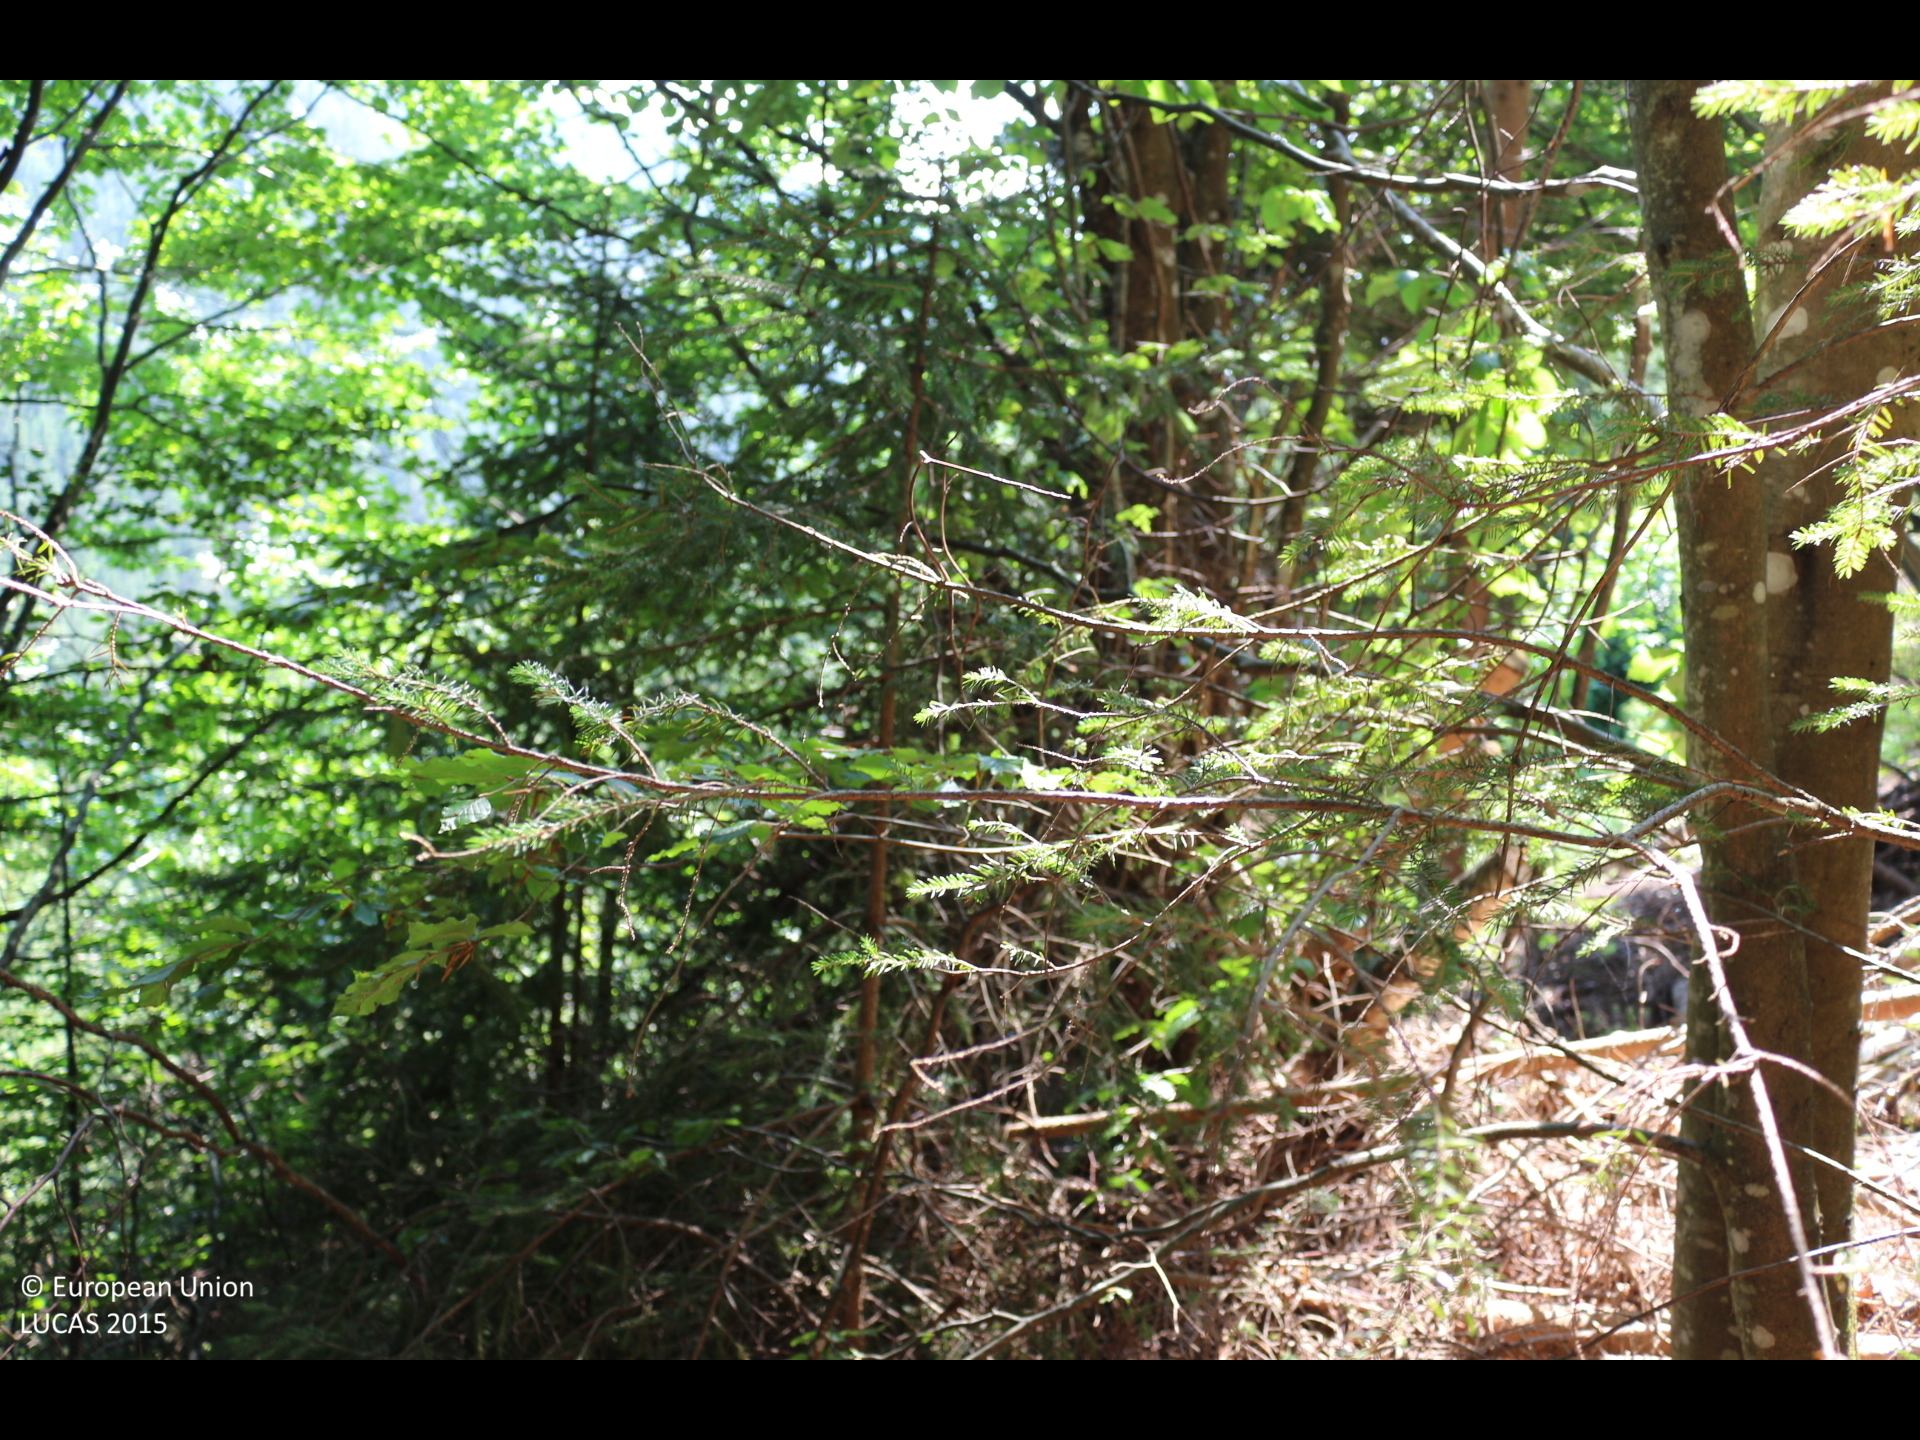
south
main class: Woodland
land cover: Spruce dominated mixed woodland
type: alpine coniferous forest
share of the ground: > 75 %
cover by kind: broadleaved forest trees 60 %, coniferous forest trees 40 %
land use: Forestry
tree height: > 5 m
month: August
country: AT
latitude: 46.8156
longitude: 14.0474
